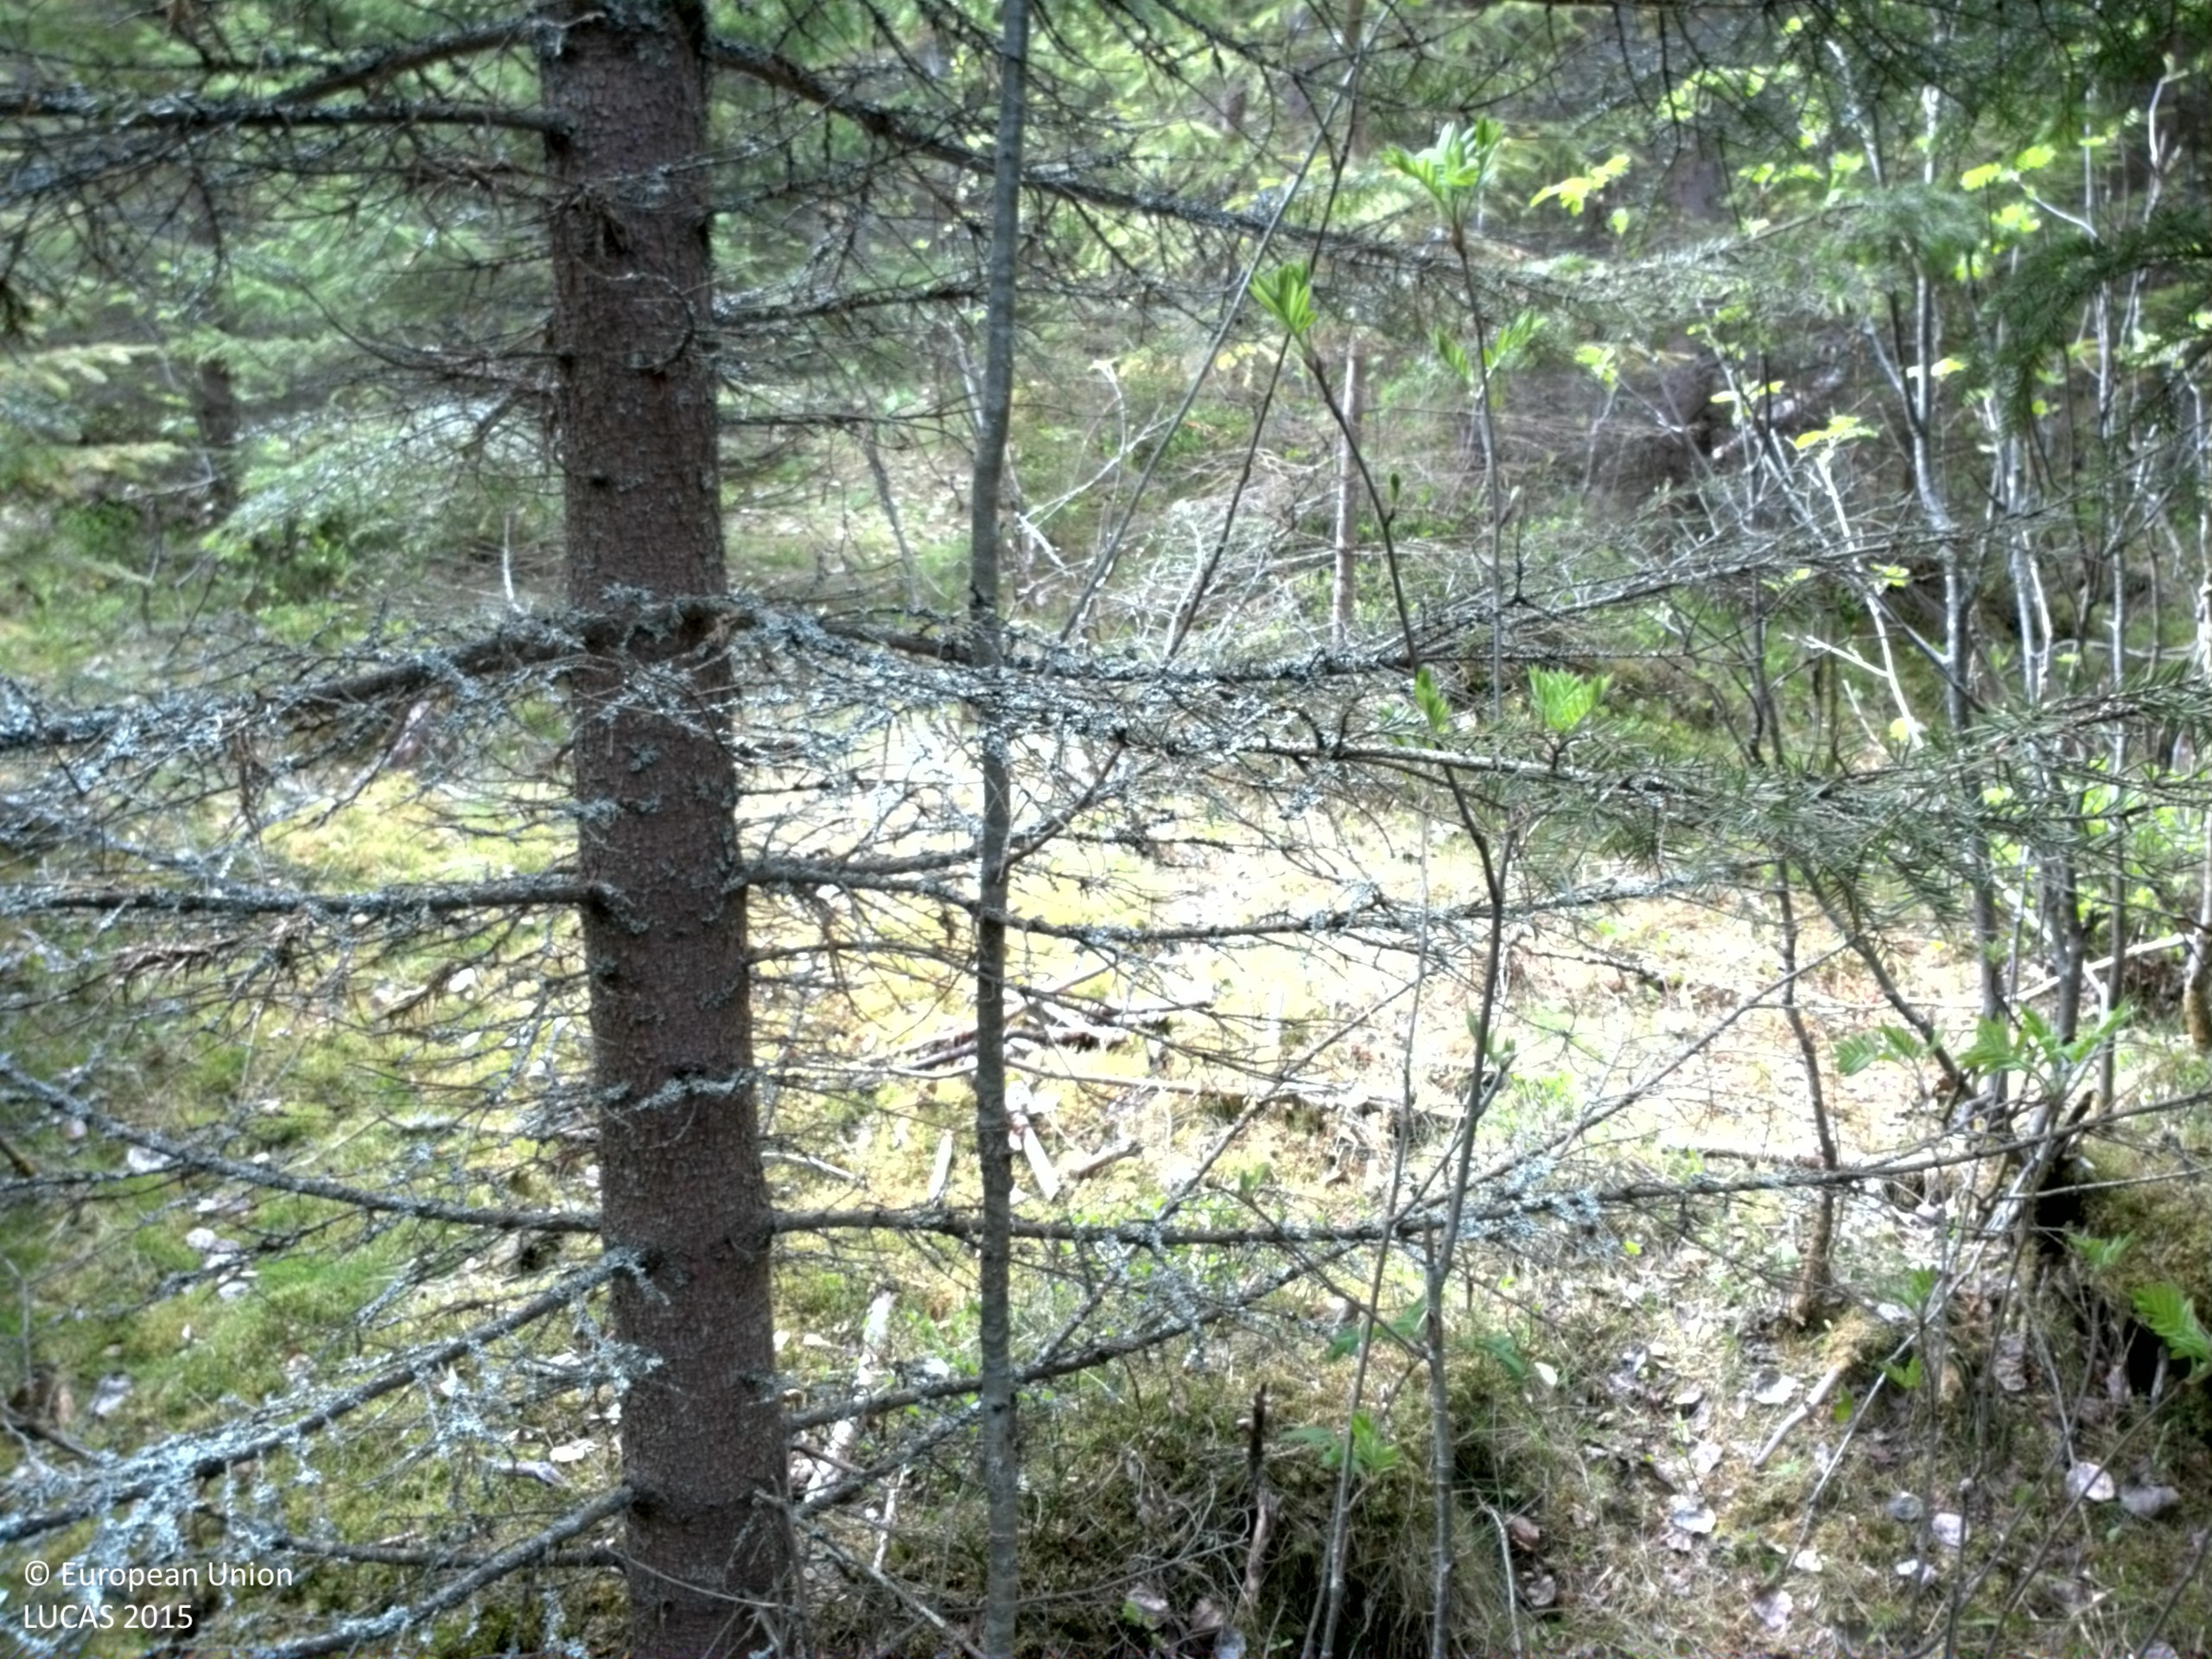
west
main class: Woodland
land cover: Spruce dominated coniferous woodland
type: boreal forest
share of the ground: > 75 %
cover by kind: coniferous forest trees 75 %, lichens and mosses 15 %, shrubs 10 %
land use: Forestry
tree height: > 5 m
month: May
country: SE
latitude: 62.8742
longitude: 17.9408
